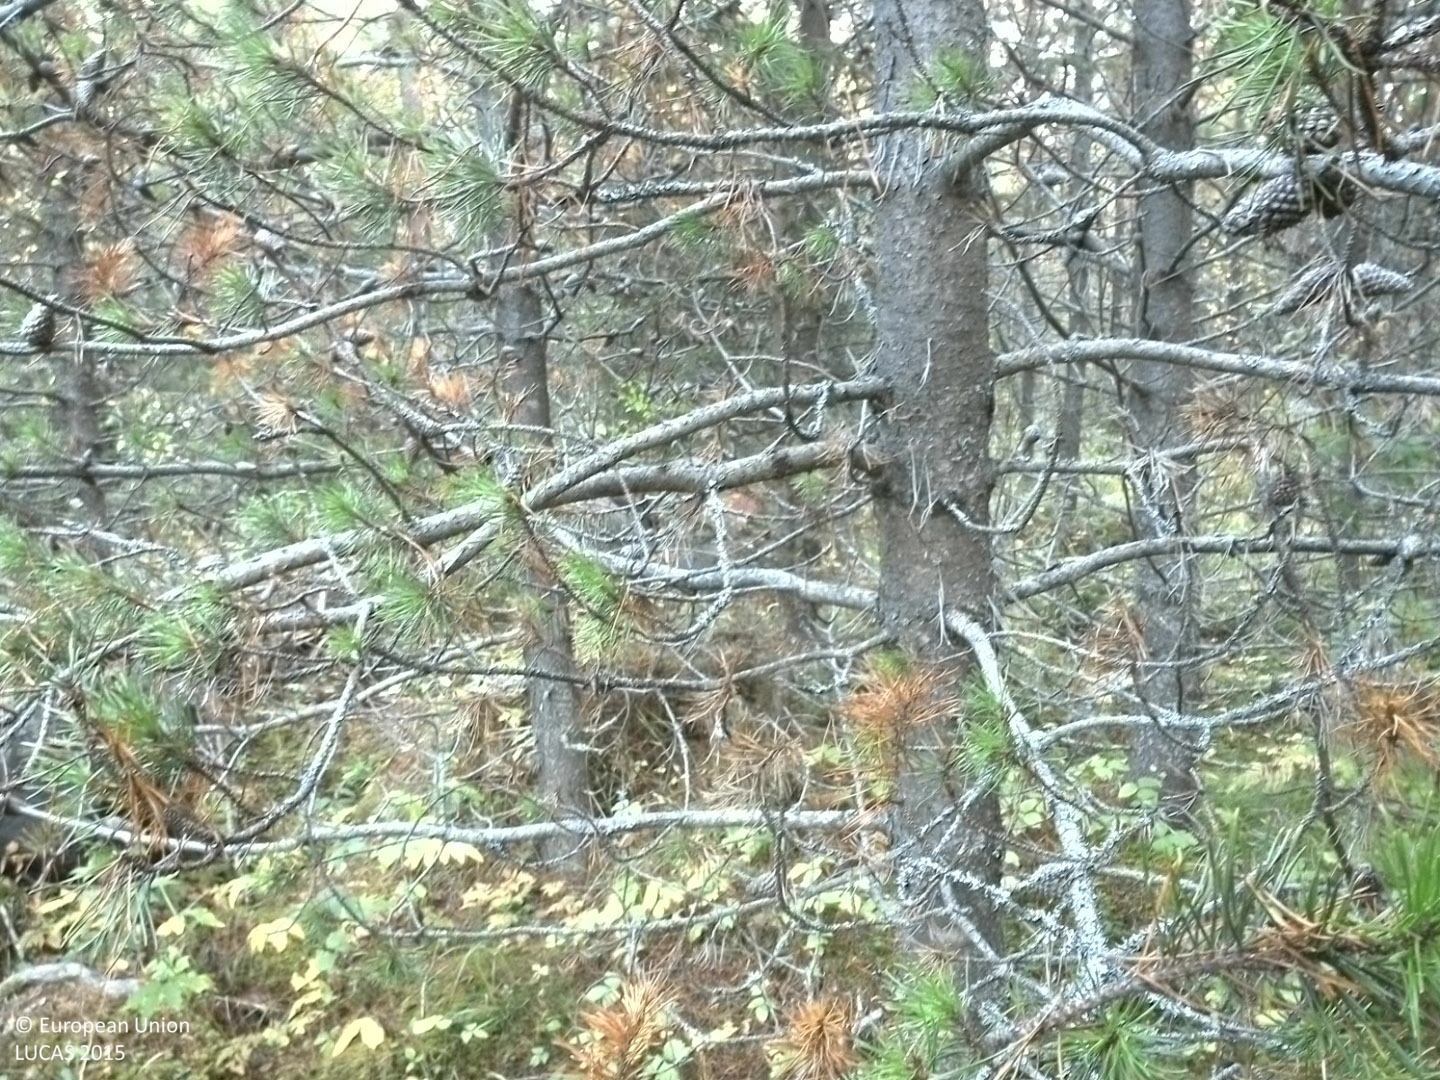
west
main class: Woodland
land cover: Pine dominated coniferous woodland
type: exotic forest
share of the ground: 50 - 75 %
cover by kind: coniferous forest trees 50 %, herbaceous plants 30 %, shrubs 15 %, broadleaved forest trees 5 %
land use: Forestry
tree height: > 5 m
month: September
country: SE
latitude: 62.2888
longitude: 15.6670
